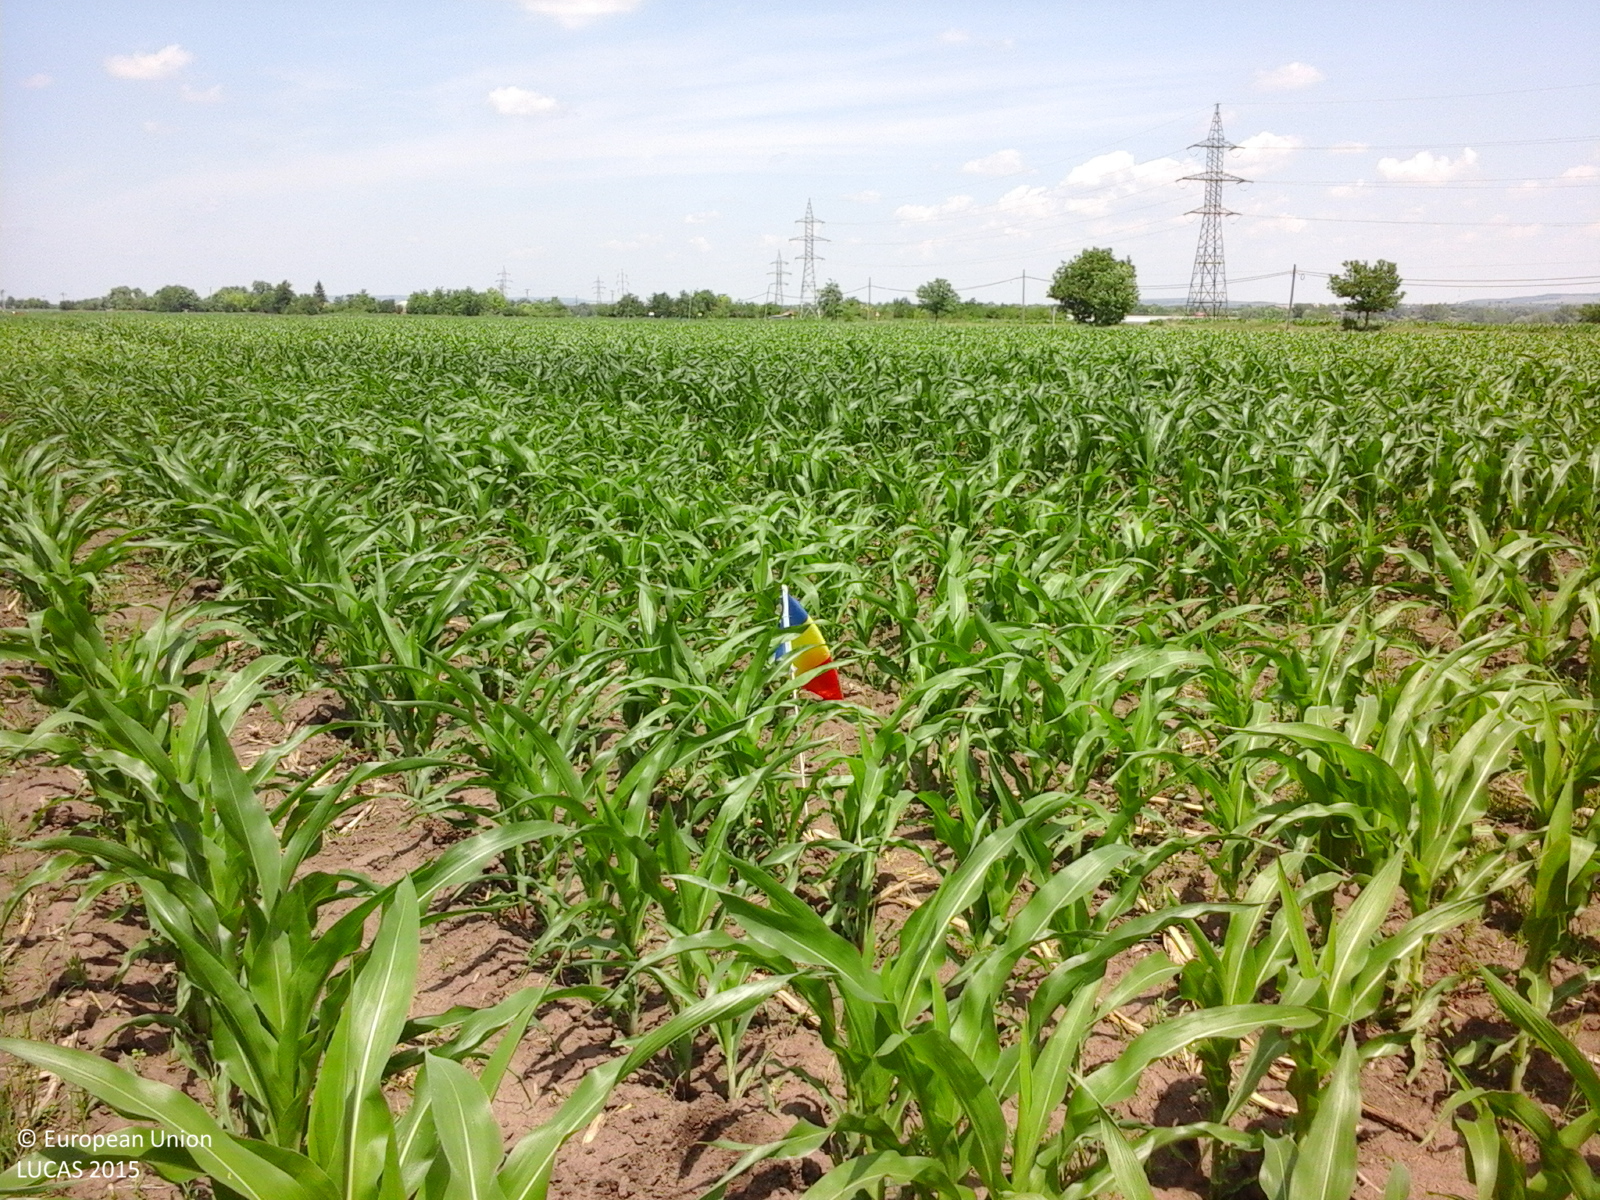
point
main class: Cropland
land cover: Maize
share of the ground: 50 - 75 %
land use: Agriculture (excluding fallow land and kitchen gardens)
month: June
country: RO
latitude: 47.5605
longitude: 27.4067
